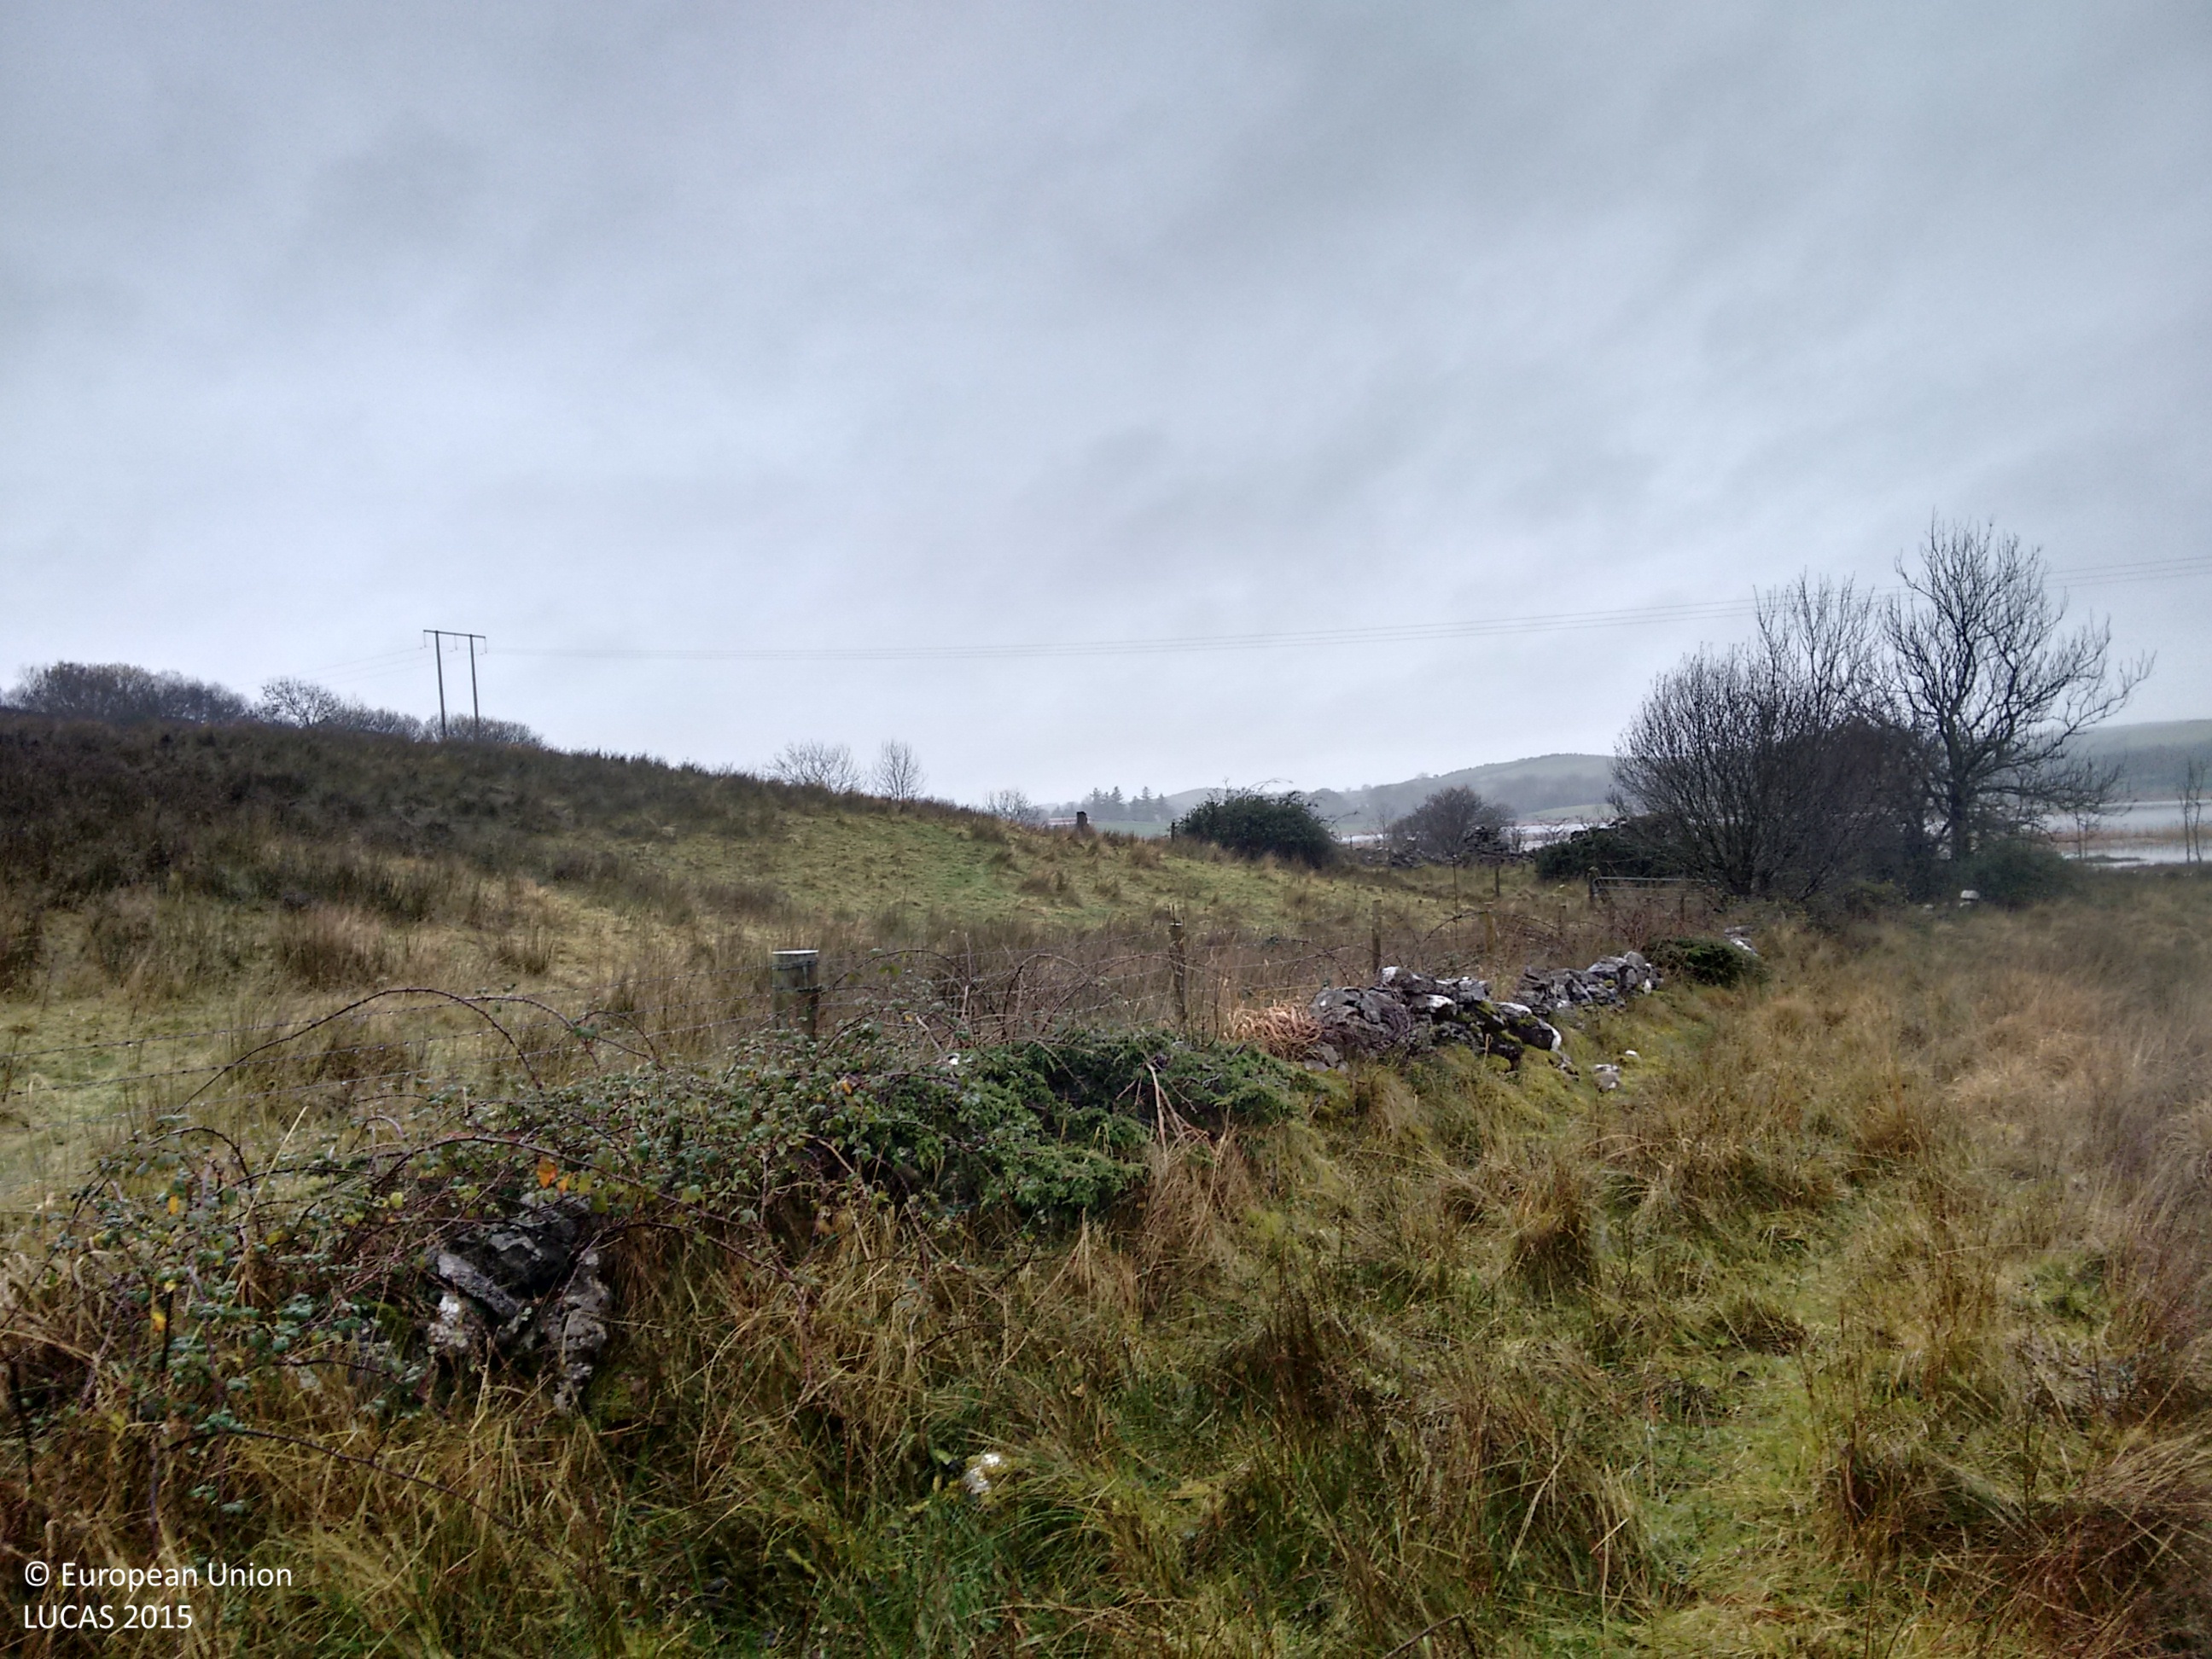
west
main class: Grassland
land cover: Grassland without tree/shrub cover
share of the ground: > 75 %
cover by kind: herbaceous plants 100 %
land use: Agriculture (excluding fallow land and kitchen gardens)
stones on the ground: < 10 %
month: November
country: IE
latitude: 54.5469
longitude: -8.1253
